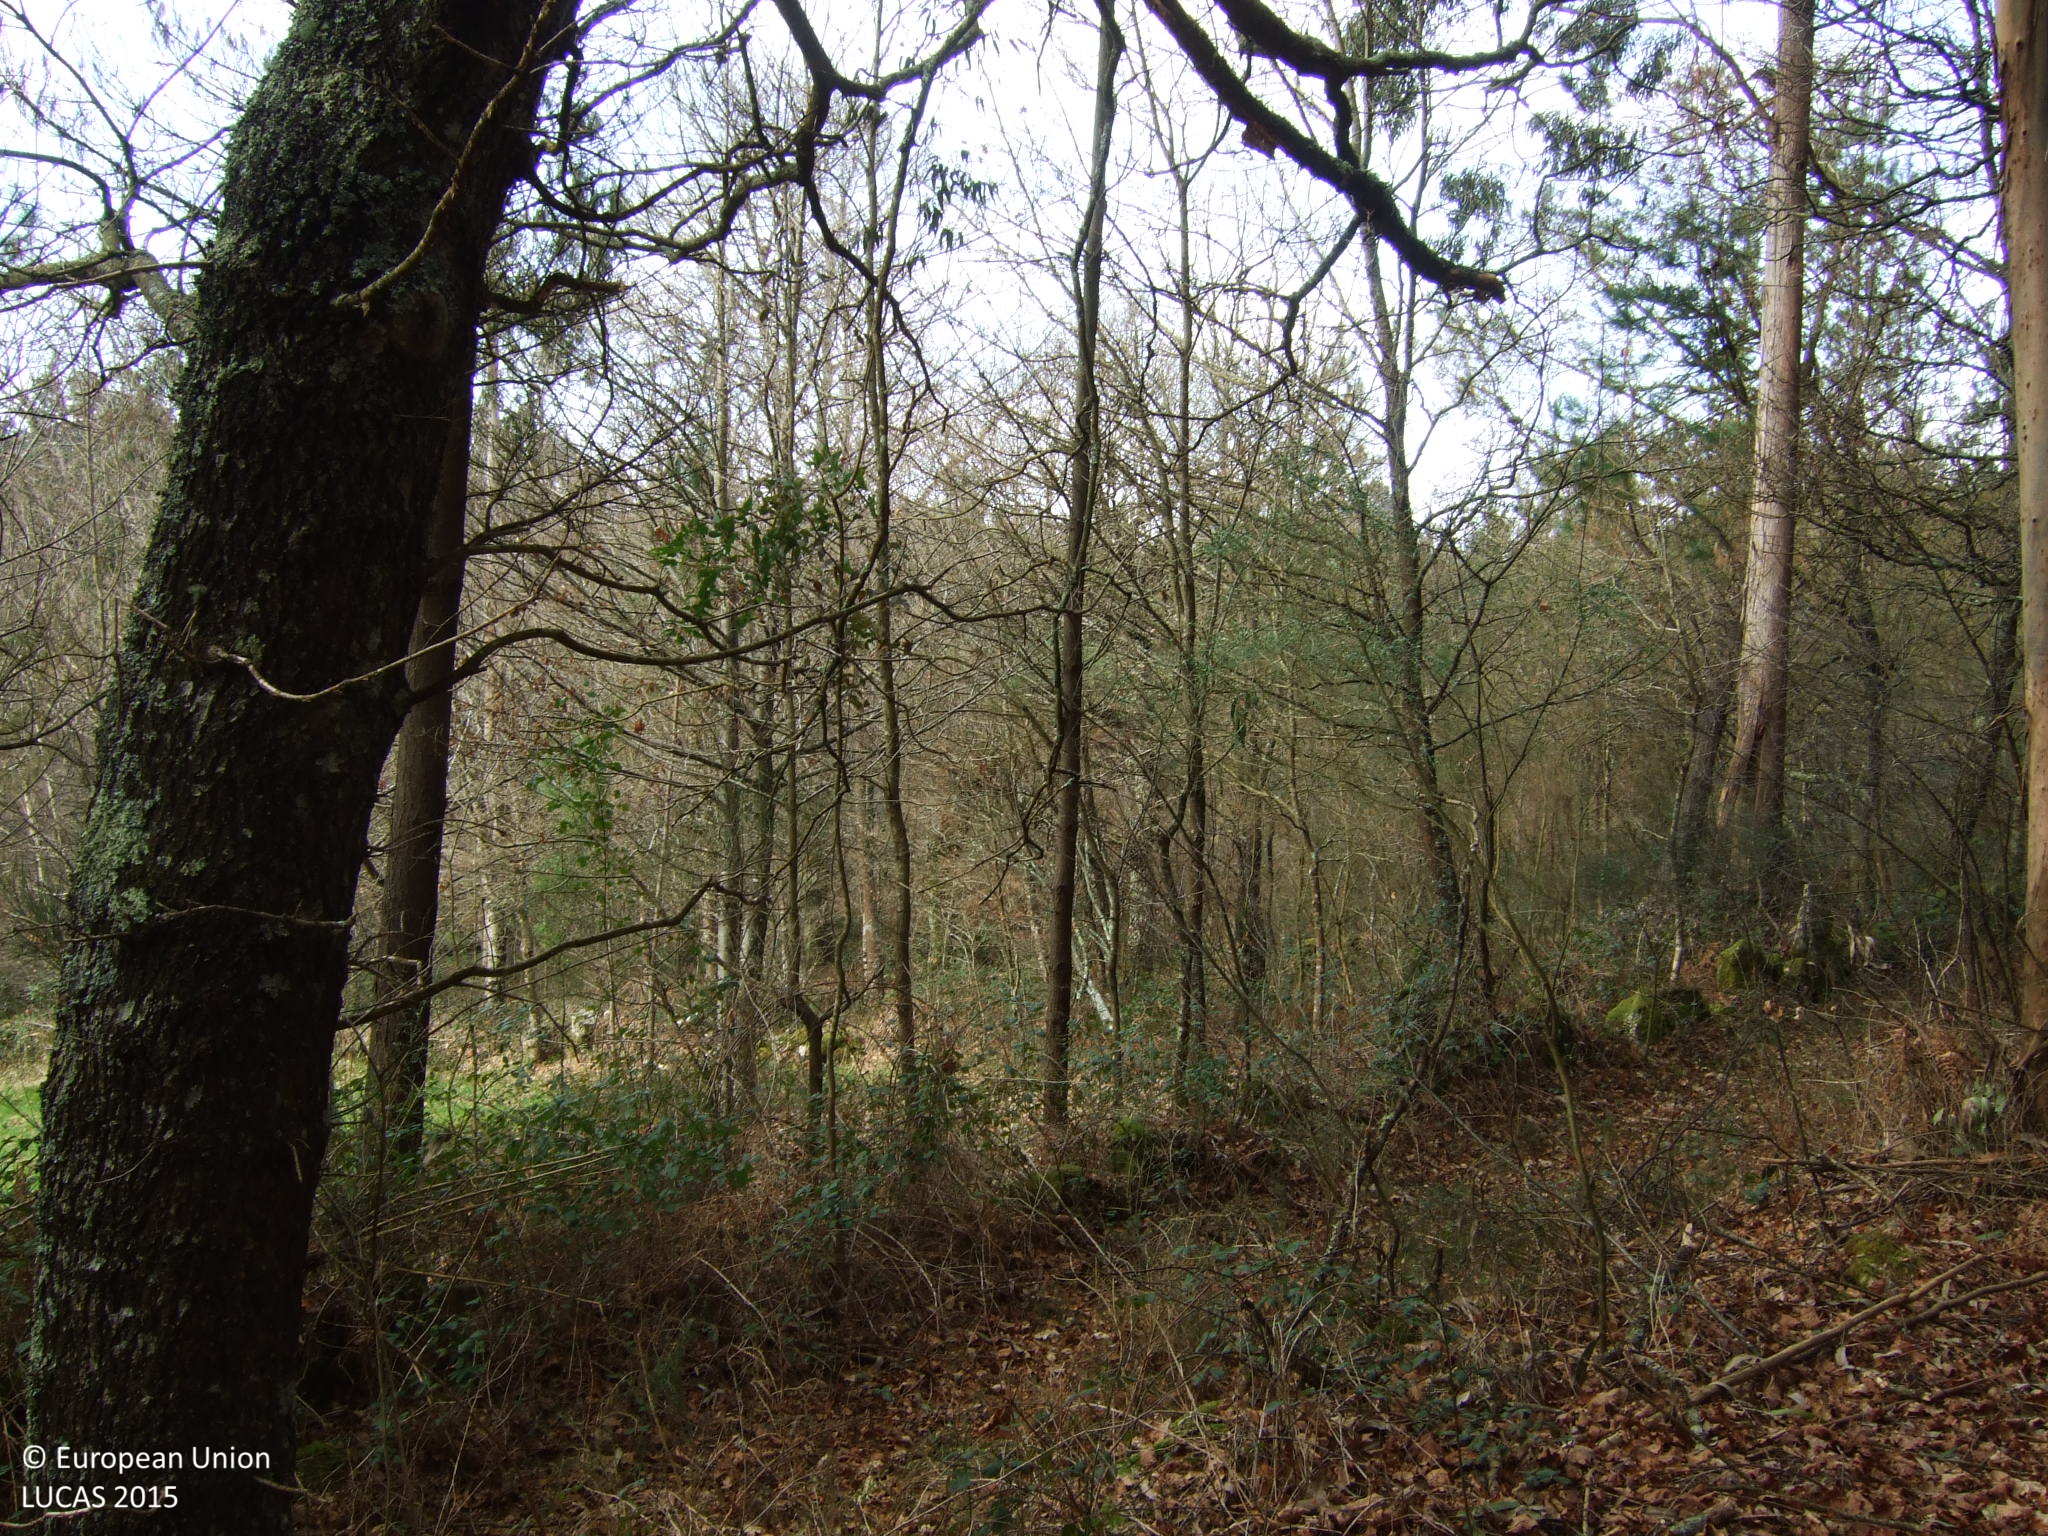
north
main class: Woodland
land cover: Broadleaved woodland
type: exotic forest
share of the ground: > 75 %
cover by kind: broadleaved forest trees 80 %, shrubs 20 %
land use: Forestry
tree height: > 5 m
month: March
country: ES
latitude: 42.8321
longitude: -7.9092
